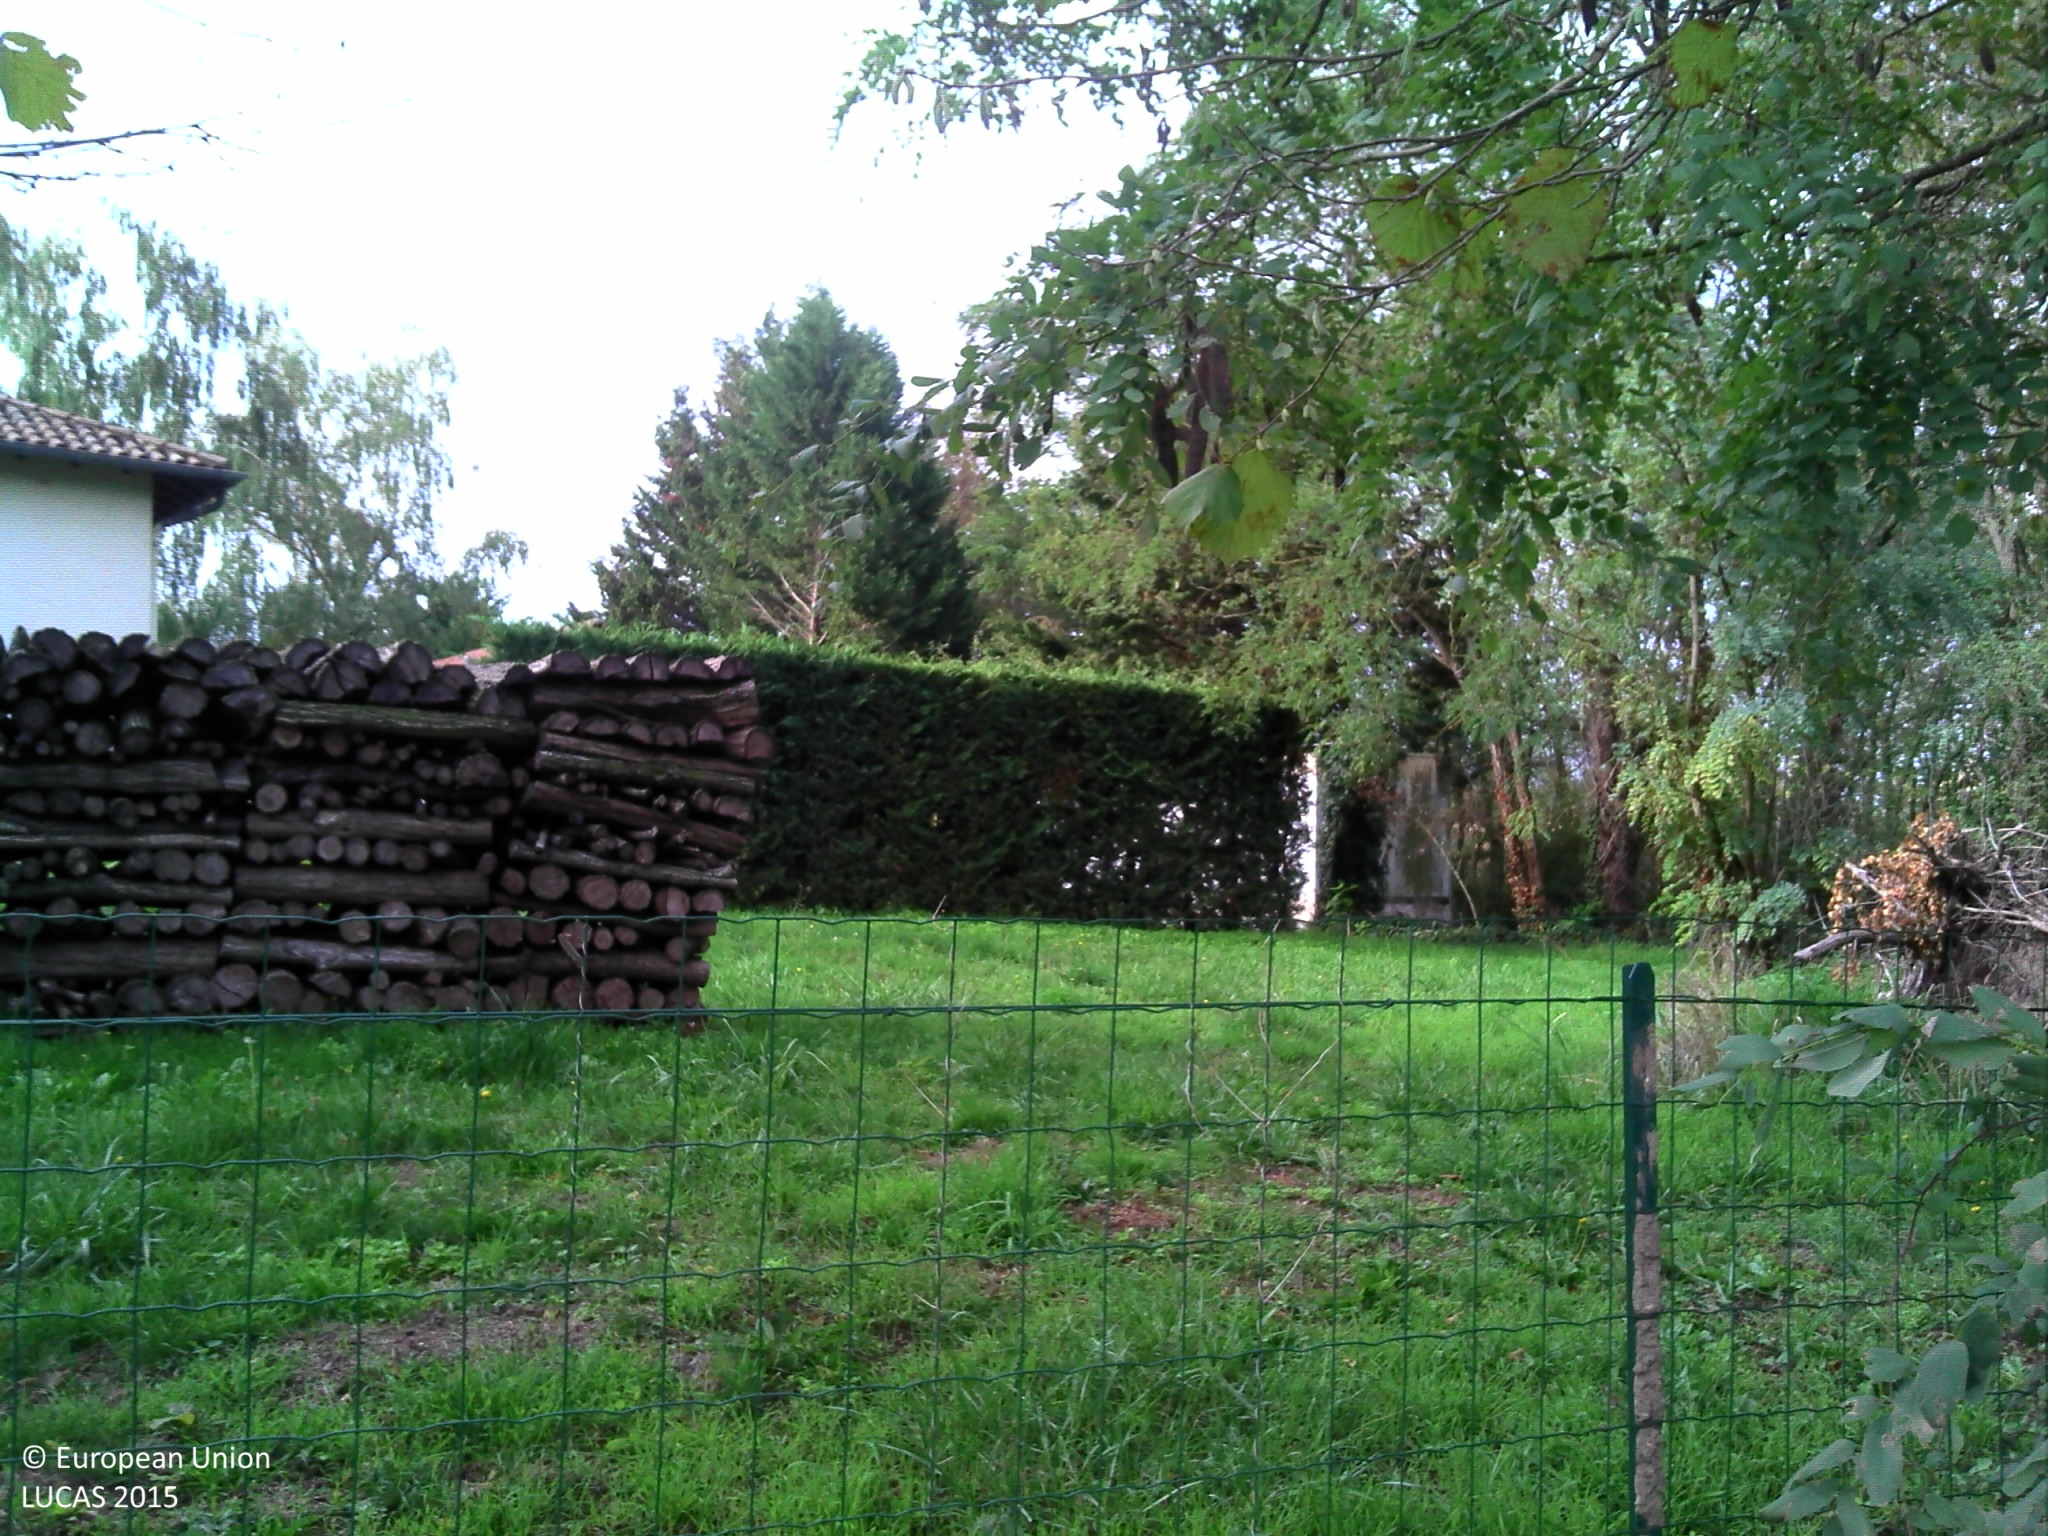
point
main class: Grassland
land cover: Grassland with sparse tree/shrub cover
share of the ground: > 75 %
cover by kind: herbaceous plants 95 %, broadleaved forest trees 5 %
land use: Residential
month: October
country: FR
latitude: 46.3928
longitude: 4.9174
